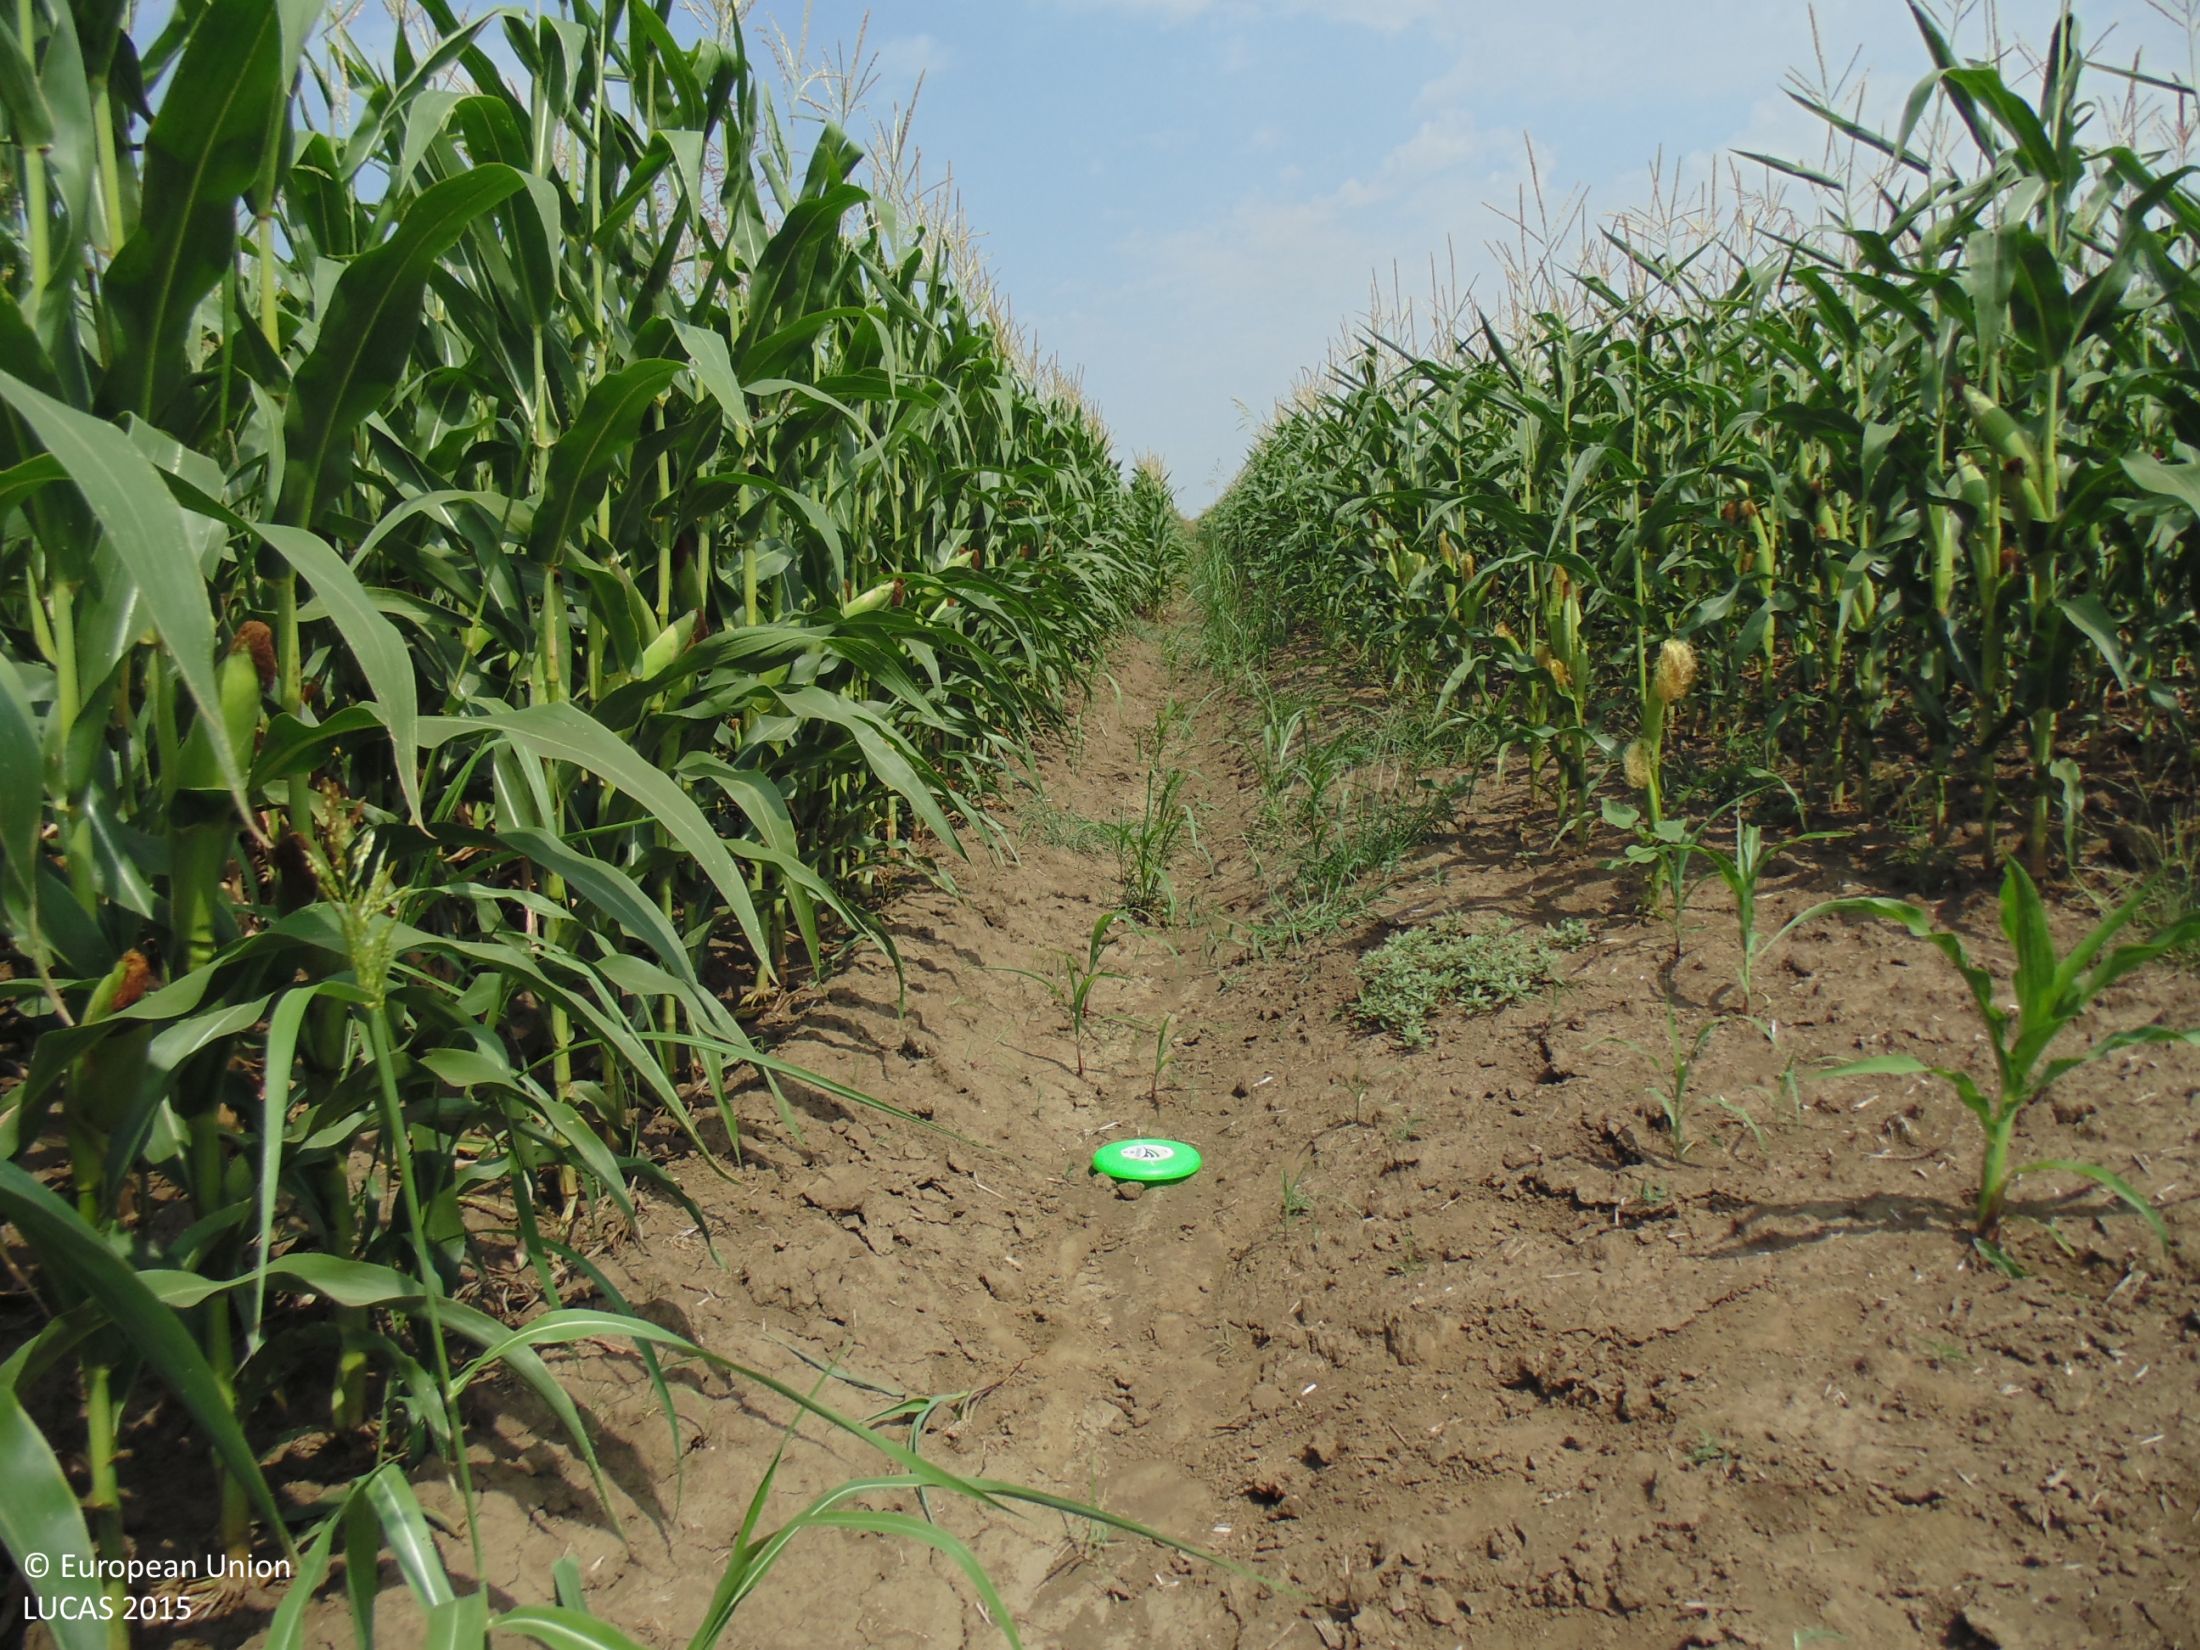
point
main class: Cropland
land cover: Maize
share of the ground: > 75 %
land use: Agriculture (excluding fallow land and kitchen gardens)
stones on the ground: < 10 %
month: August
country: BG
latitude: 43.7922
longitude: 28.1105
